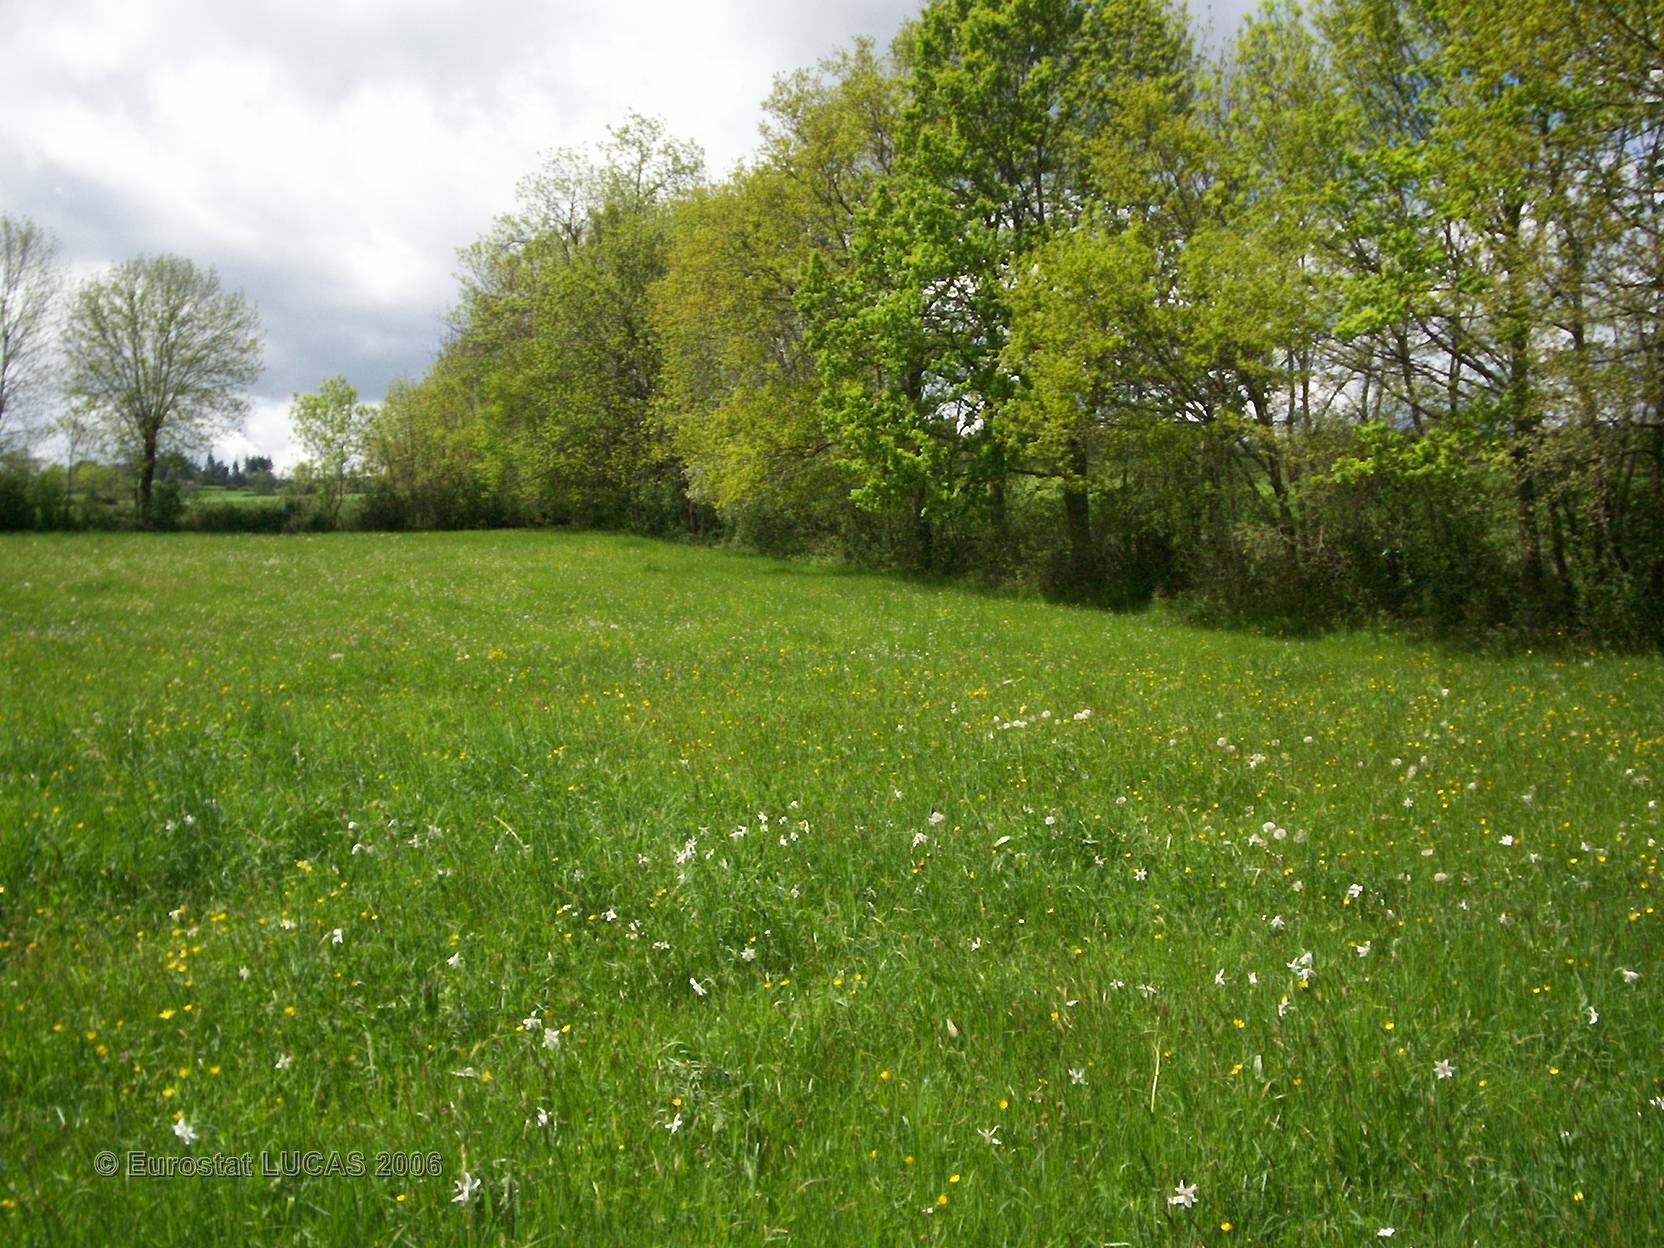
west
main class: Grassland
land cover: Grassland without tree/shrub cover
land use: Agriculture (excluding fallow land and kitchen gardens)
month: May
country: FR
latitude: 45.2561
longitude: 3.3122
